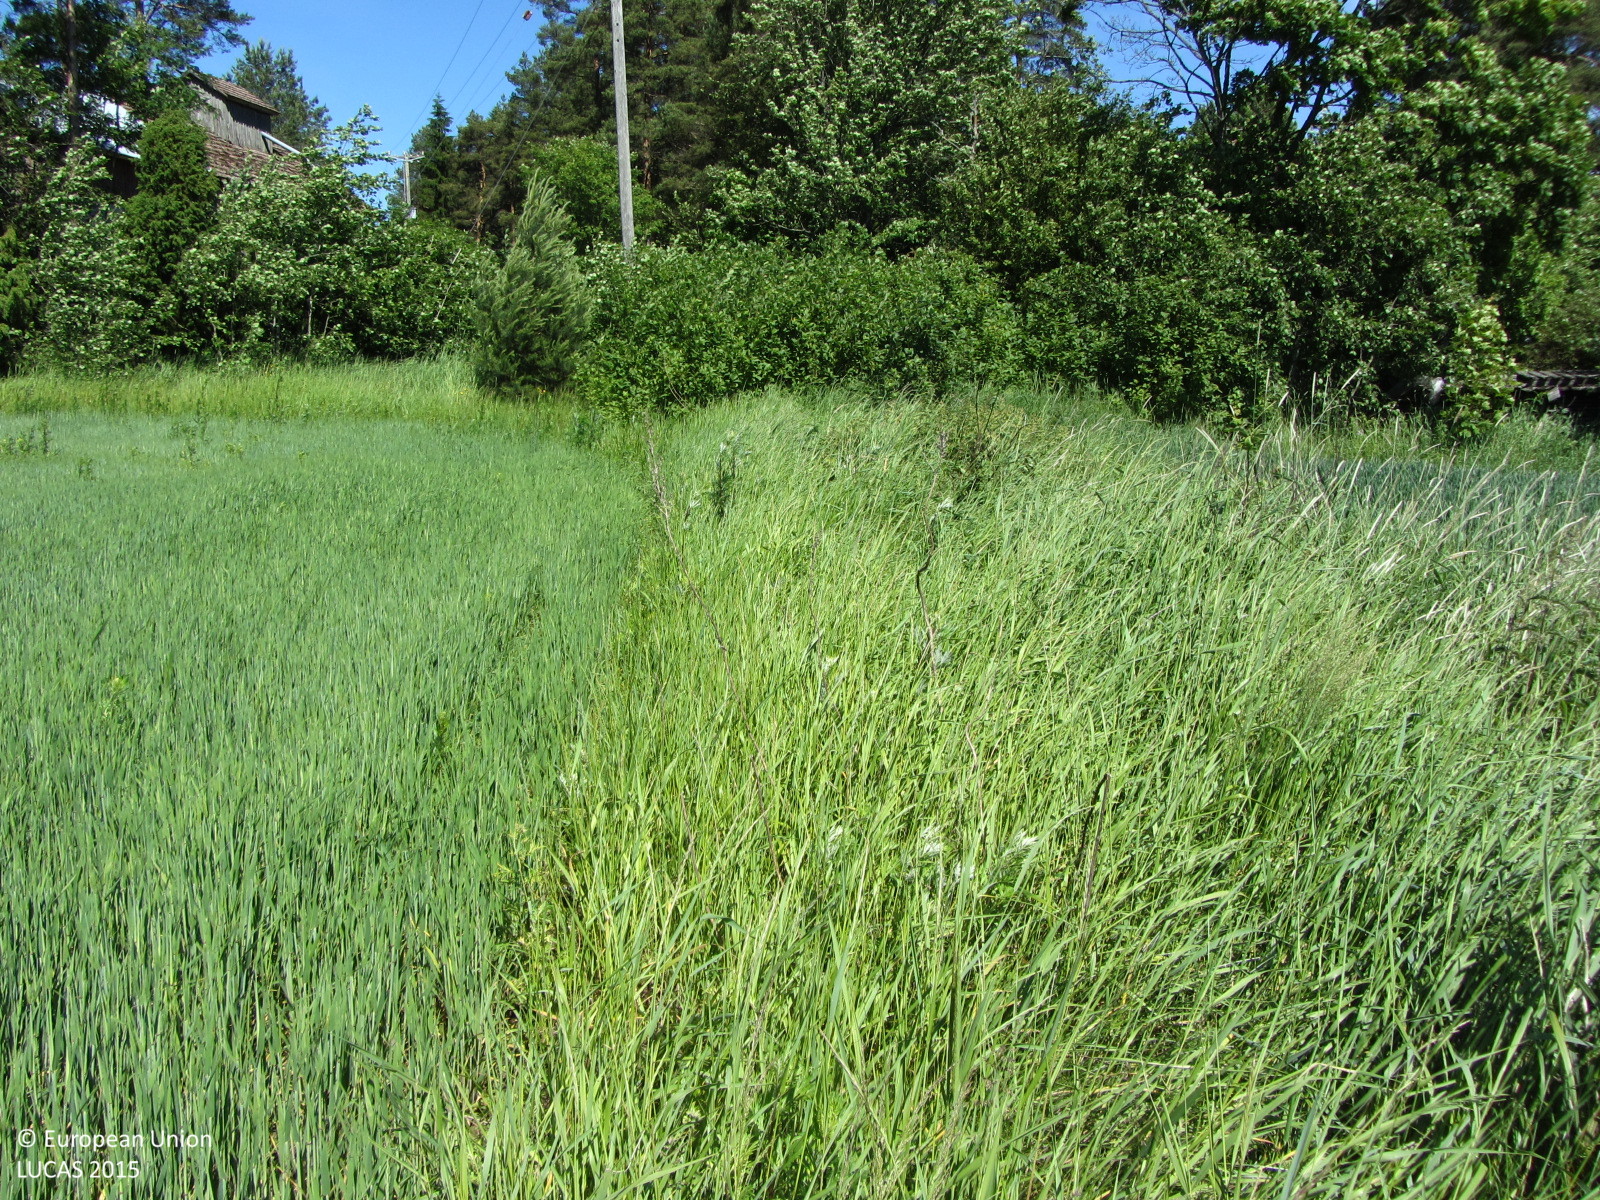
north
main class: Cropland
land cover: Barley
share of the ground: > 75 %
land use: Agriculture (excluding fallow land and kitchen gardens)
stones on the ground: < 10 %
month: June
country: FI
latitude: 60.3173
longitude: 23.2817
